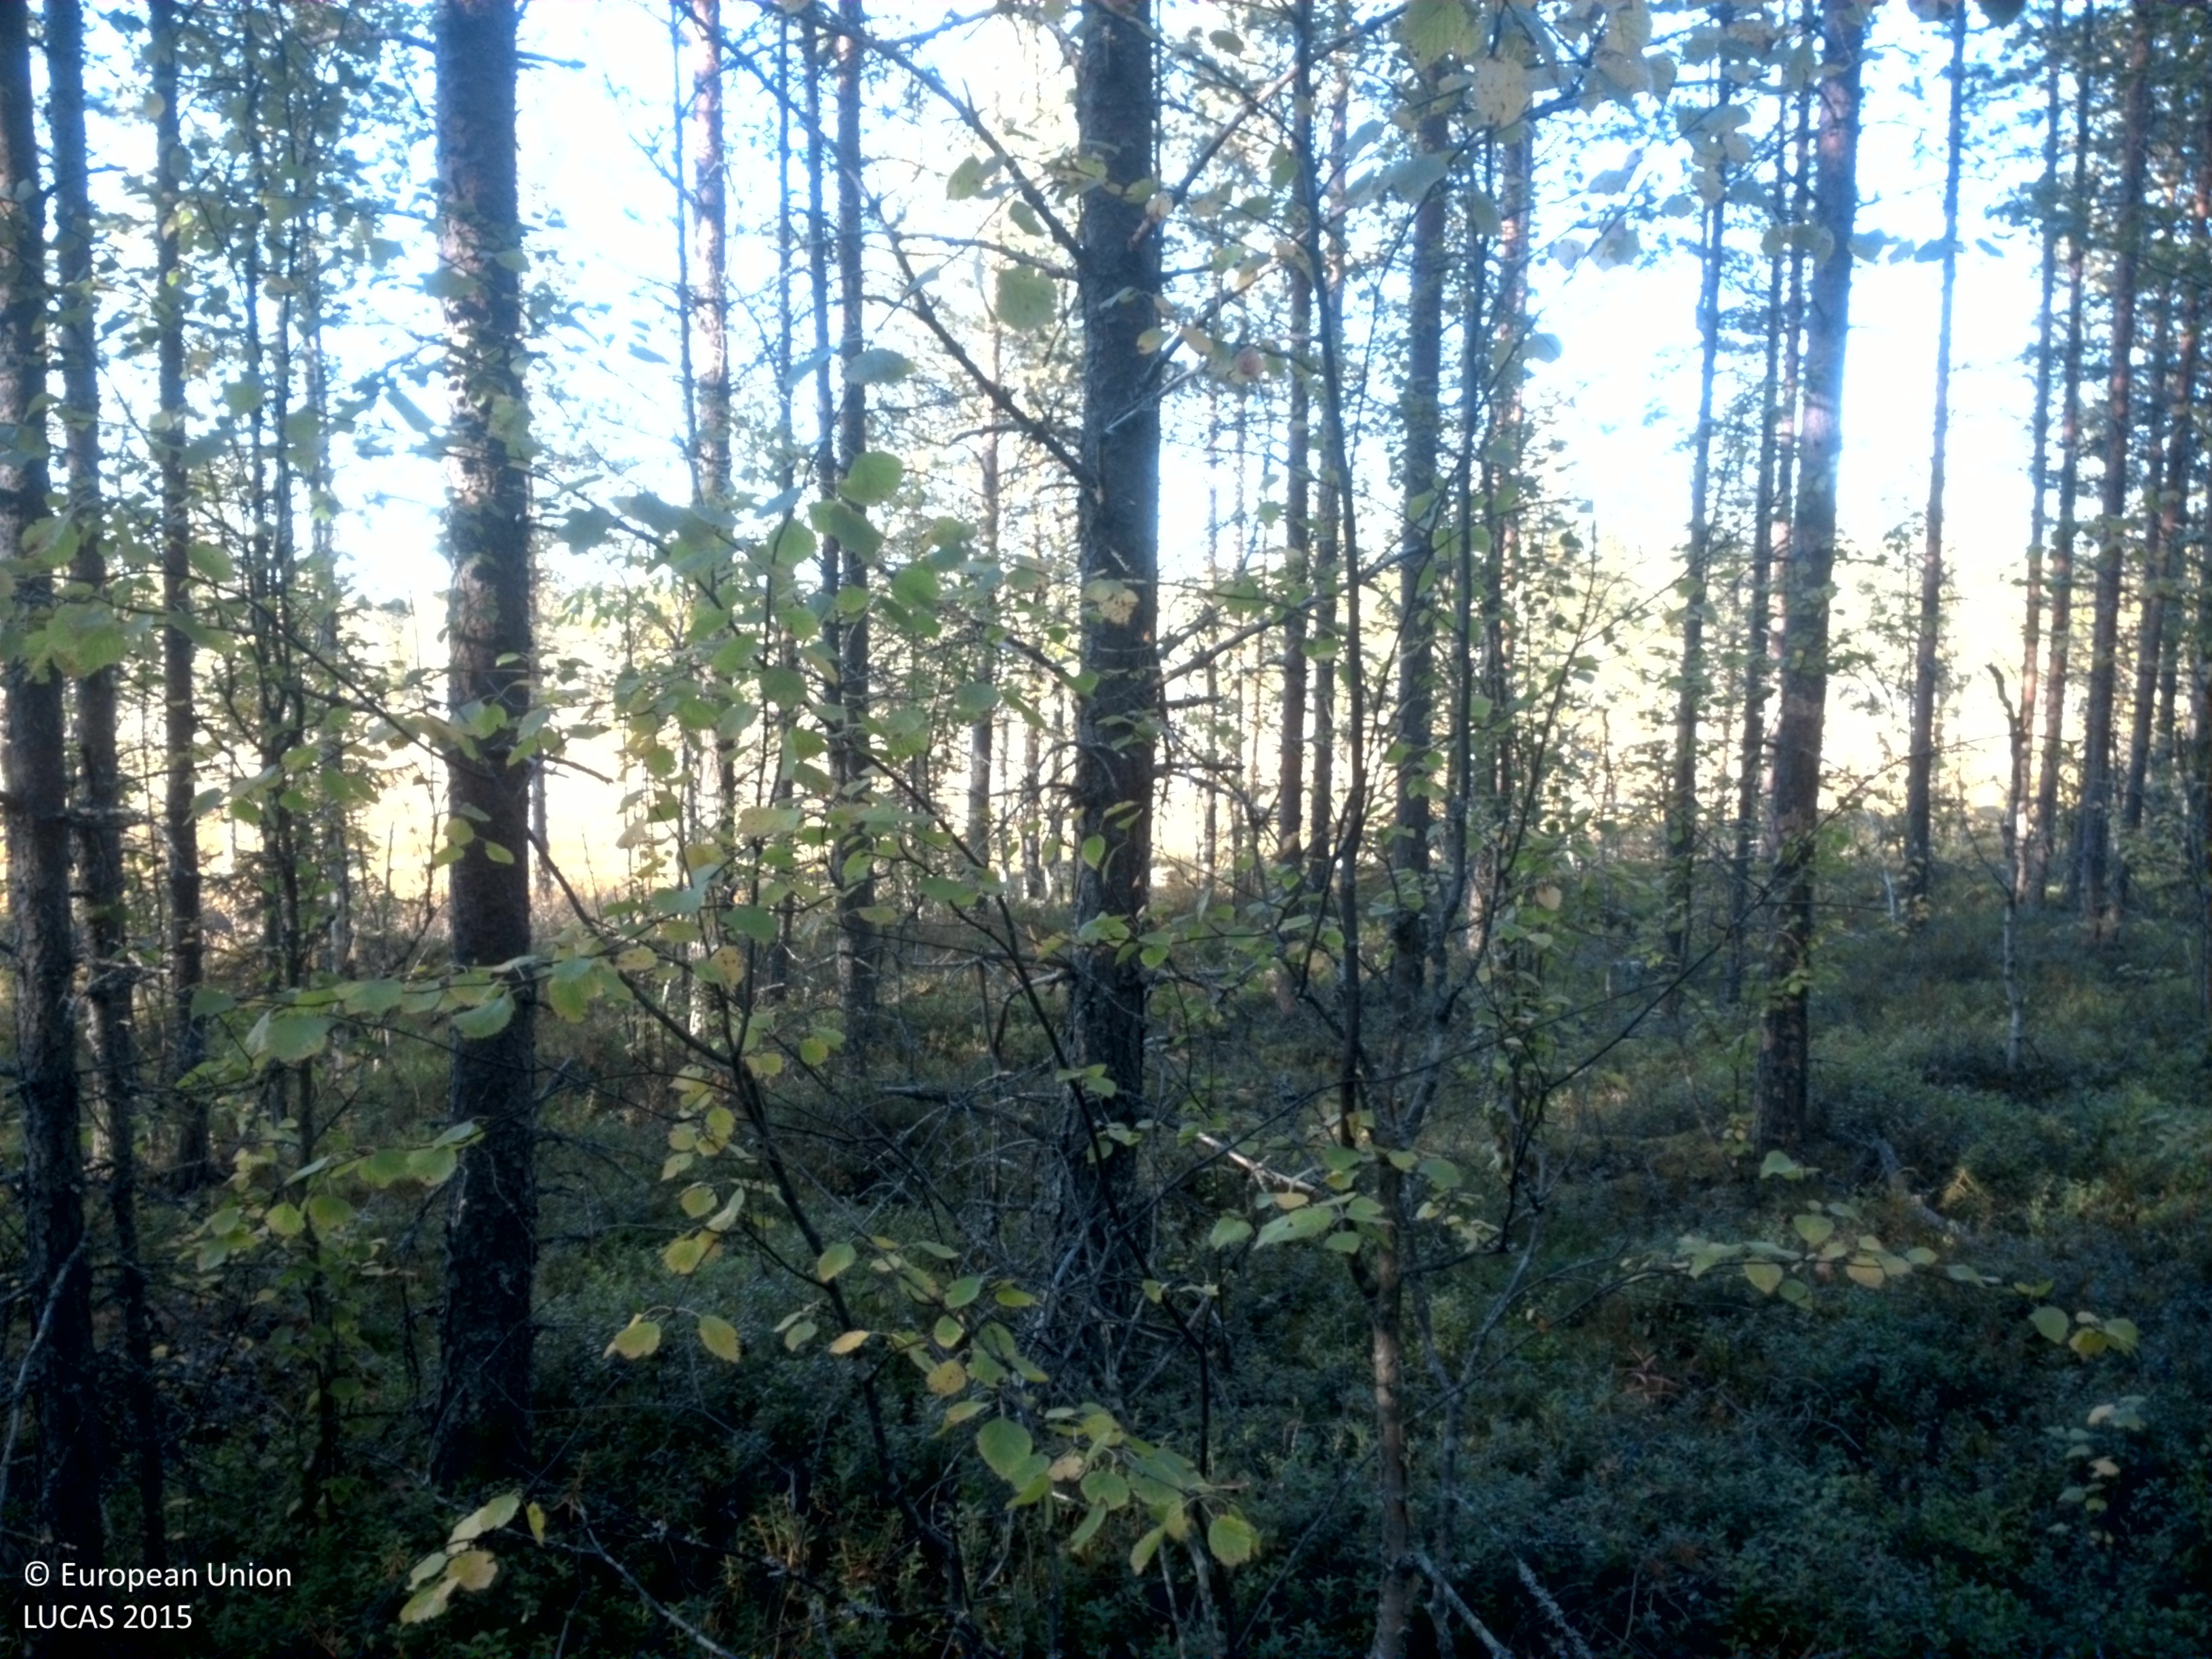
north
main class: Woodland
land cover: Pine dominated mixed woodland
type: boreal forest
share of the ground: 50 - 75 %
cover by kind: coniferous forest trees 45 %, shrubs 30 %, broadleaved forest trees 15 %, lichens and mosses 10 %
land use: Forestry
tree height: > 5 m
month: September
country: SE
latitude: 64.3719
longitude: 19.7337
